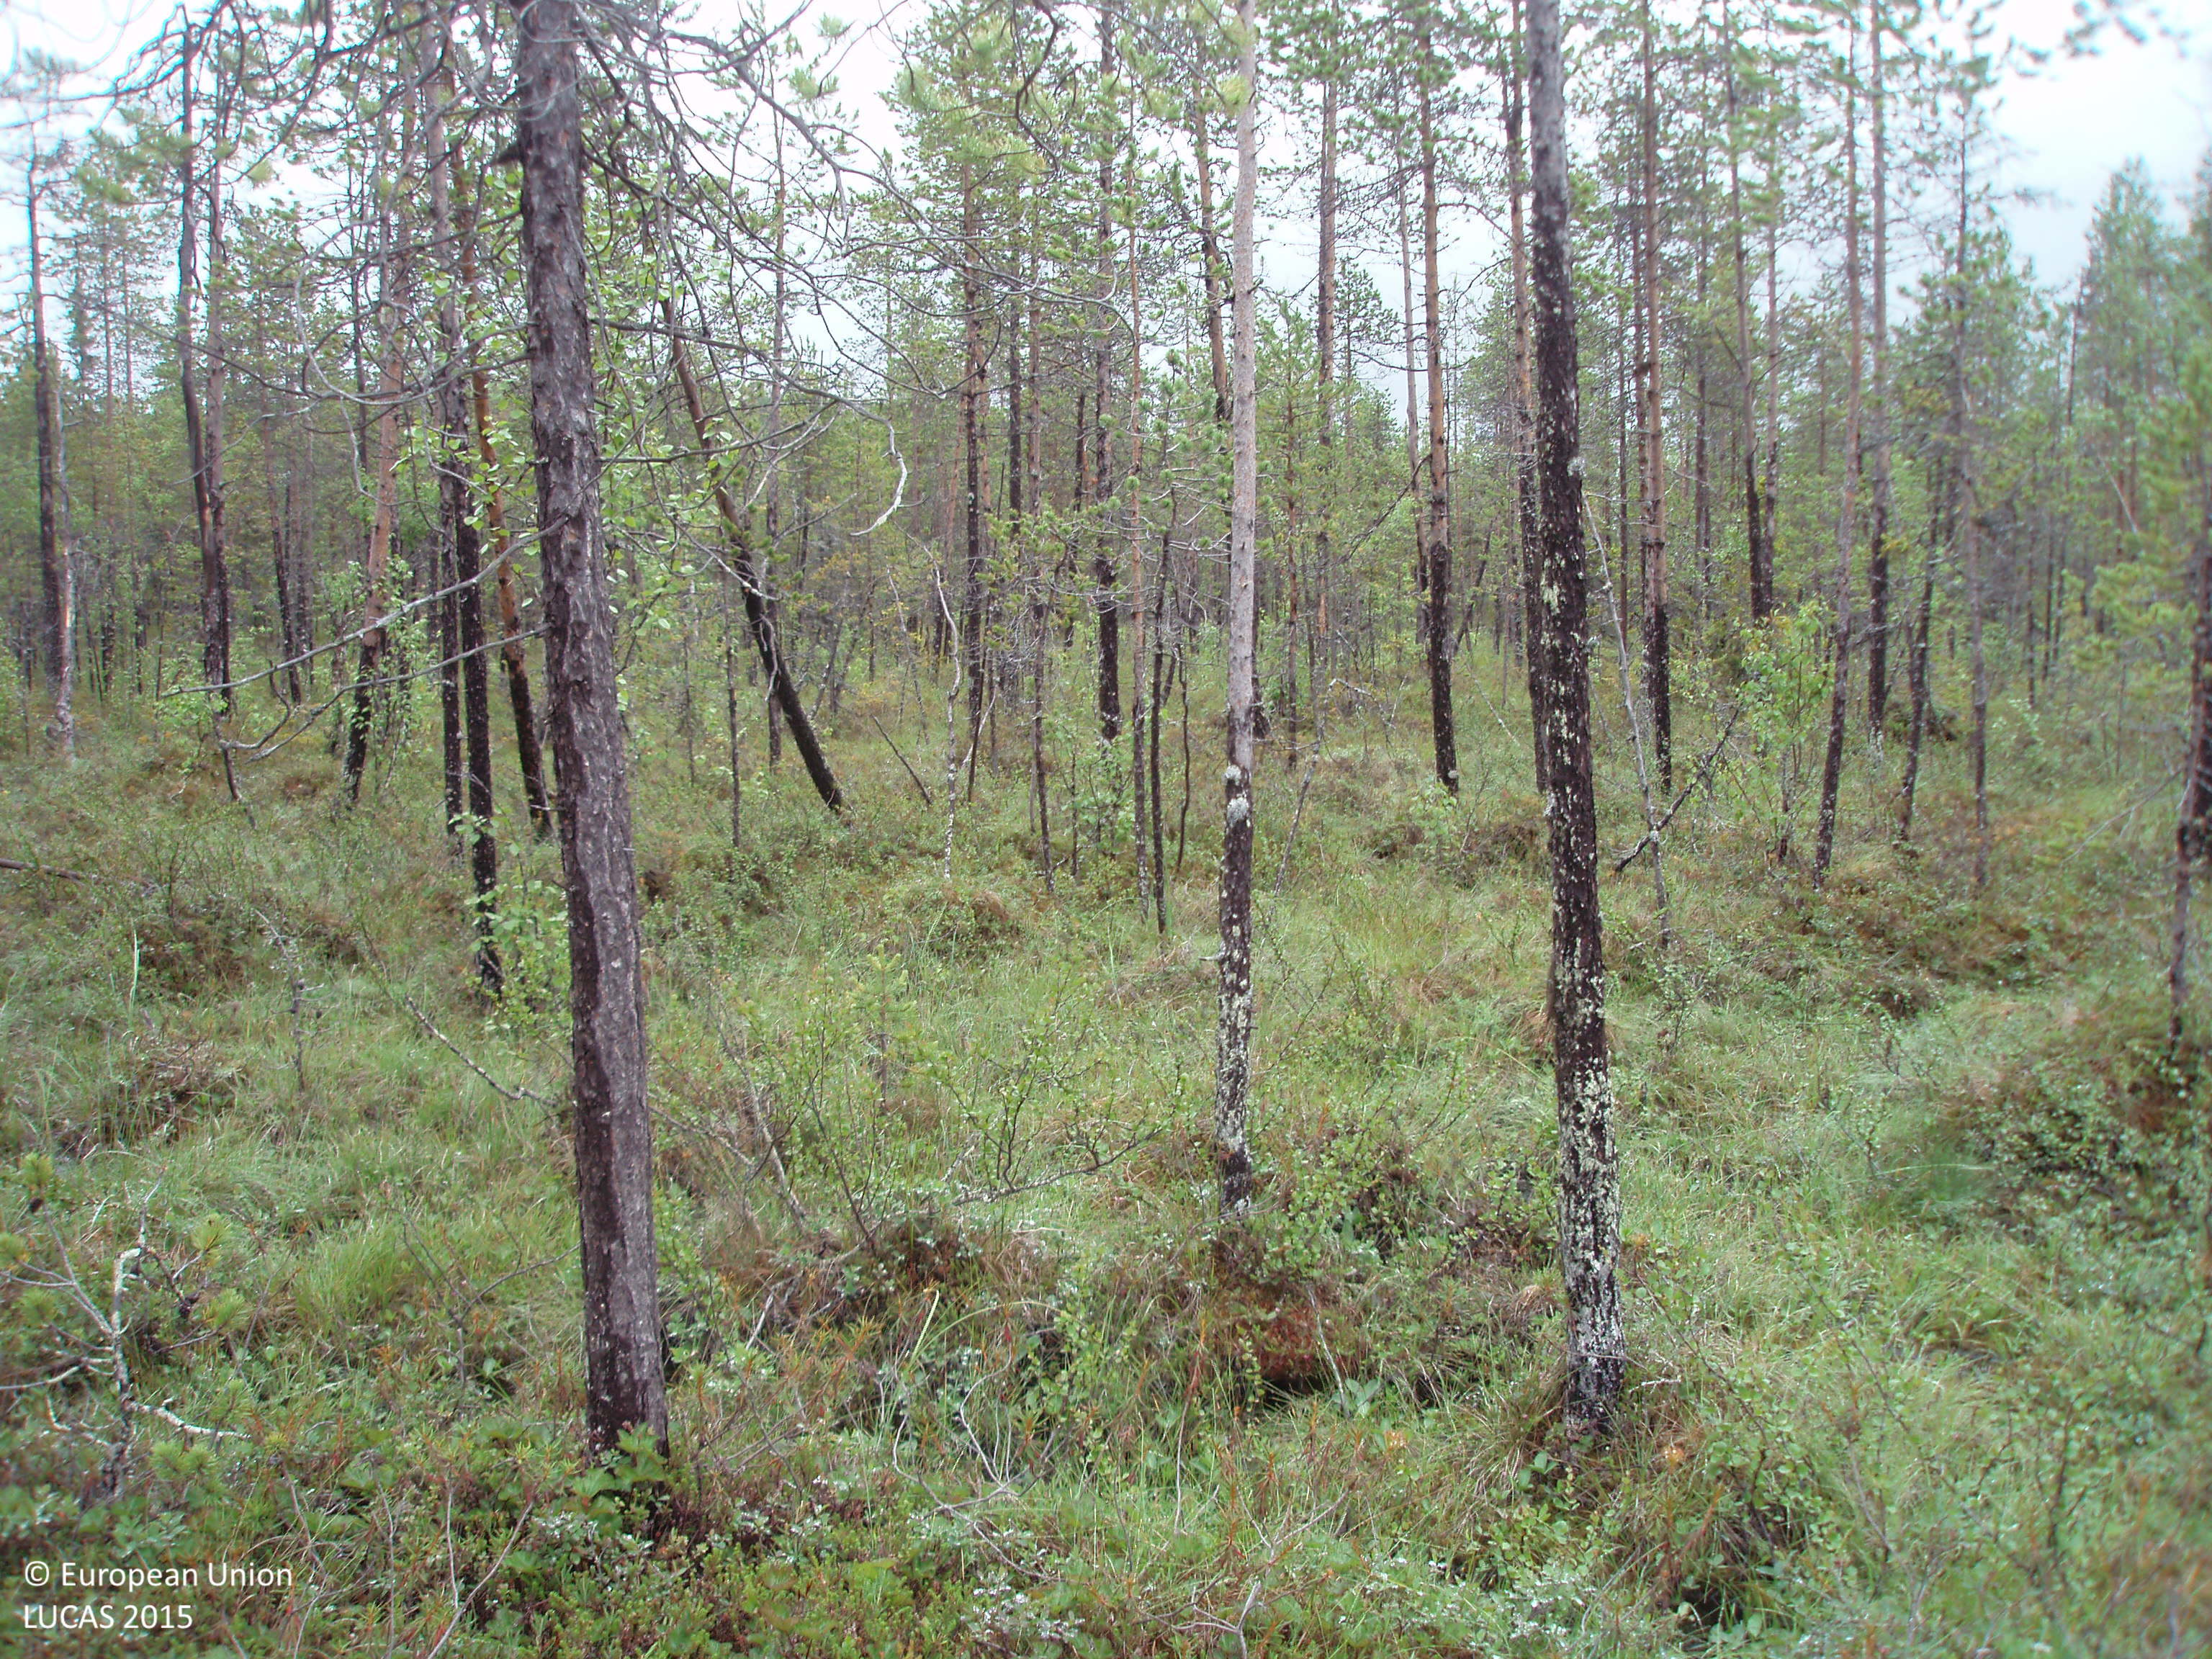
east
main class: Woodland
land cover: Pine dominated coniferous woodland
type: mire and swamp forests
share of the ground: 25 - 50 %
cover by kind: shrubs 70 %, coniferous forest trees 30 %
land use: Semi-natural and natural areas not in use
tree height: > 5 m
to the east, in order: Pine dominated coniferous woodland; Other coniferous woodland; Other mixed woodland; Pine dominated coniferous woodland
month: July
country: FI
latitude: 67.1717
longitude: 28.6403
